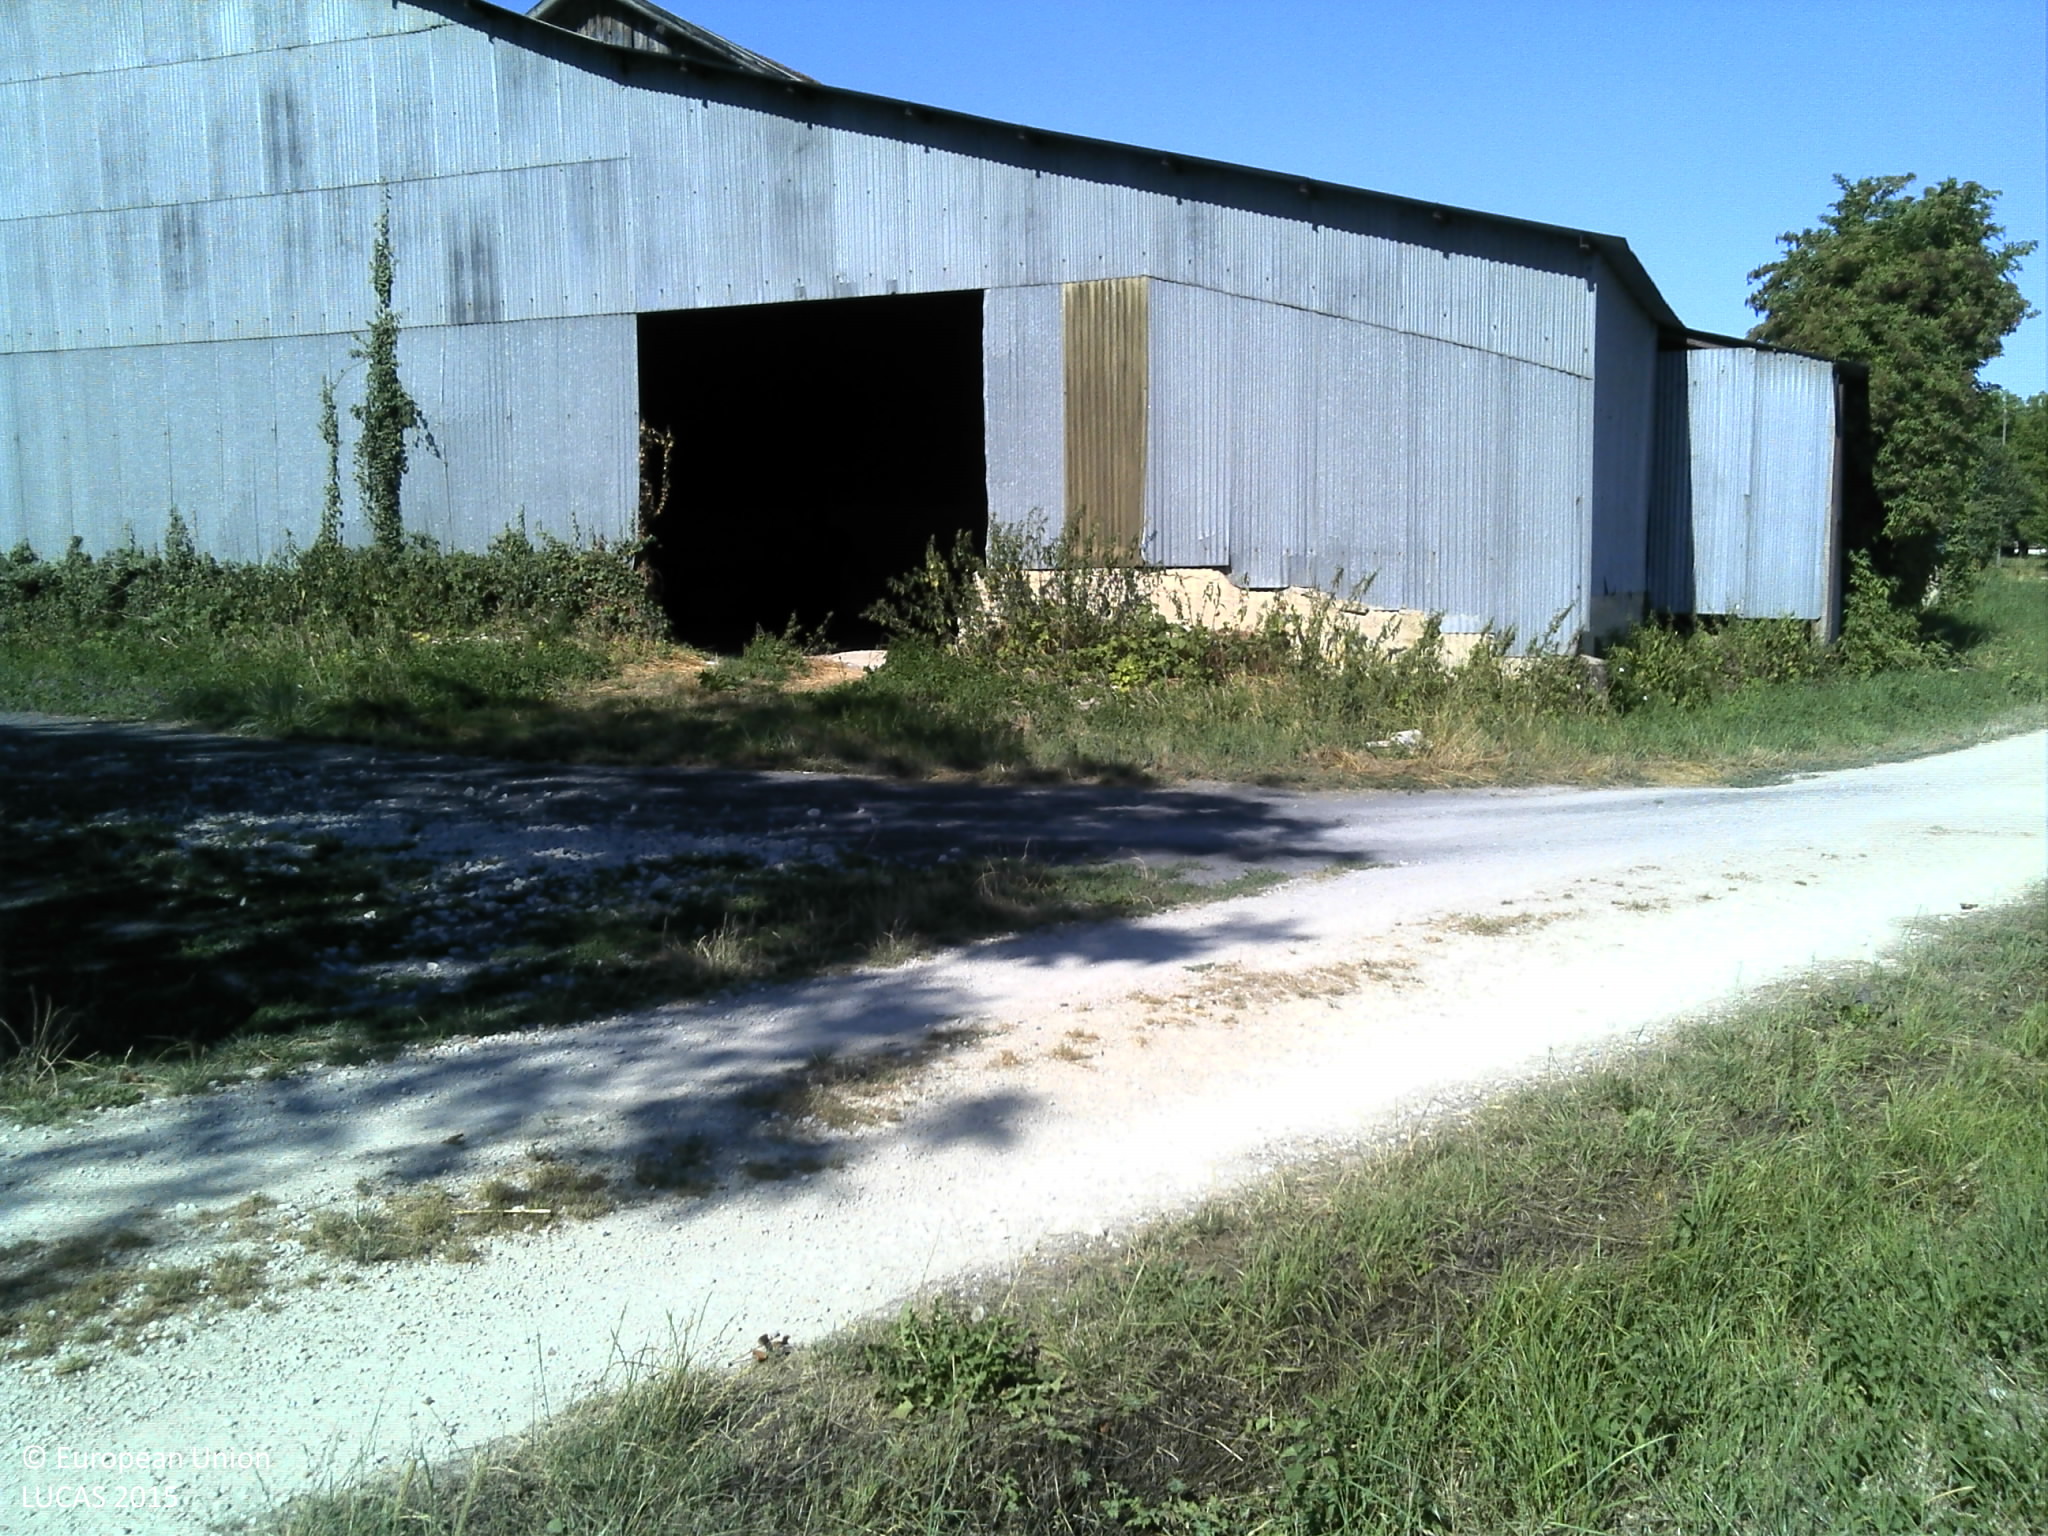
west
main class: Cropland
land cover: Common wheat
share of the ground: > 75 %
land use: Agriculture (excluding fallow land and kitchen gardens)
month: August
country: FR
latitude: 49.1645
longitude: 4.7996
